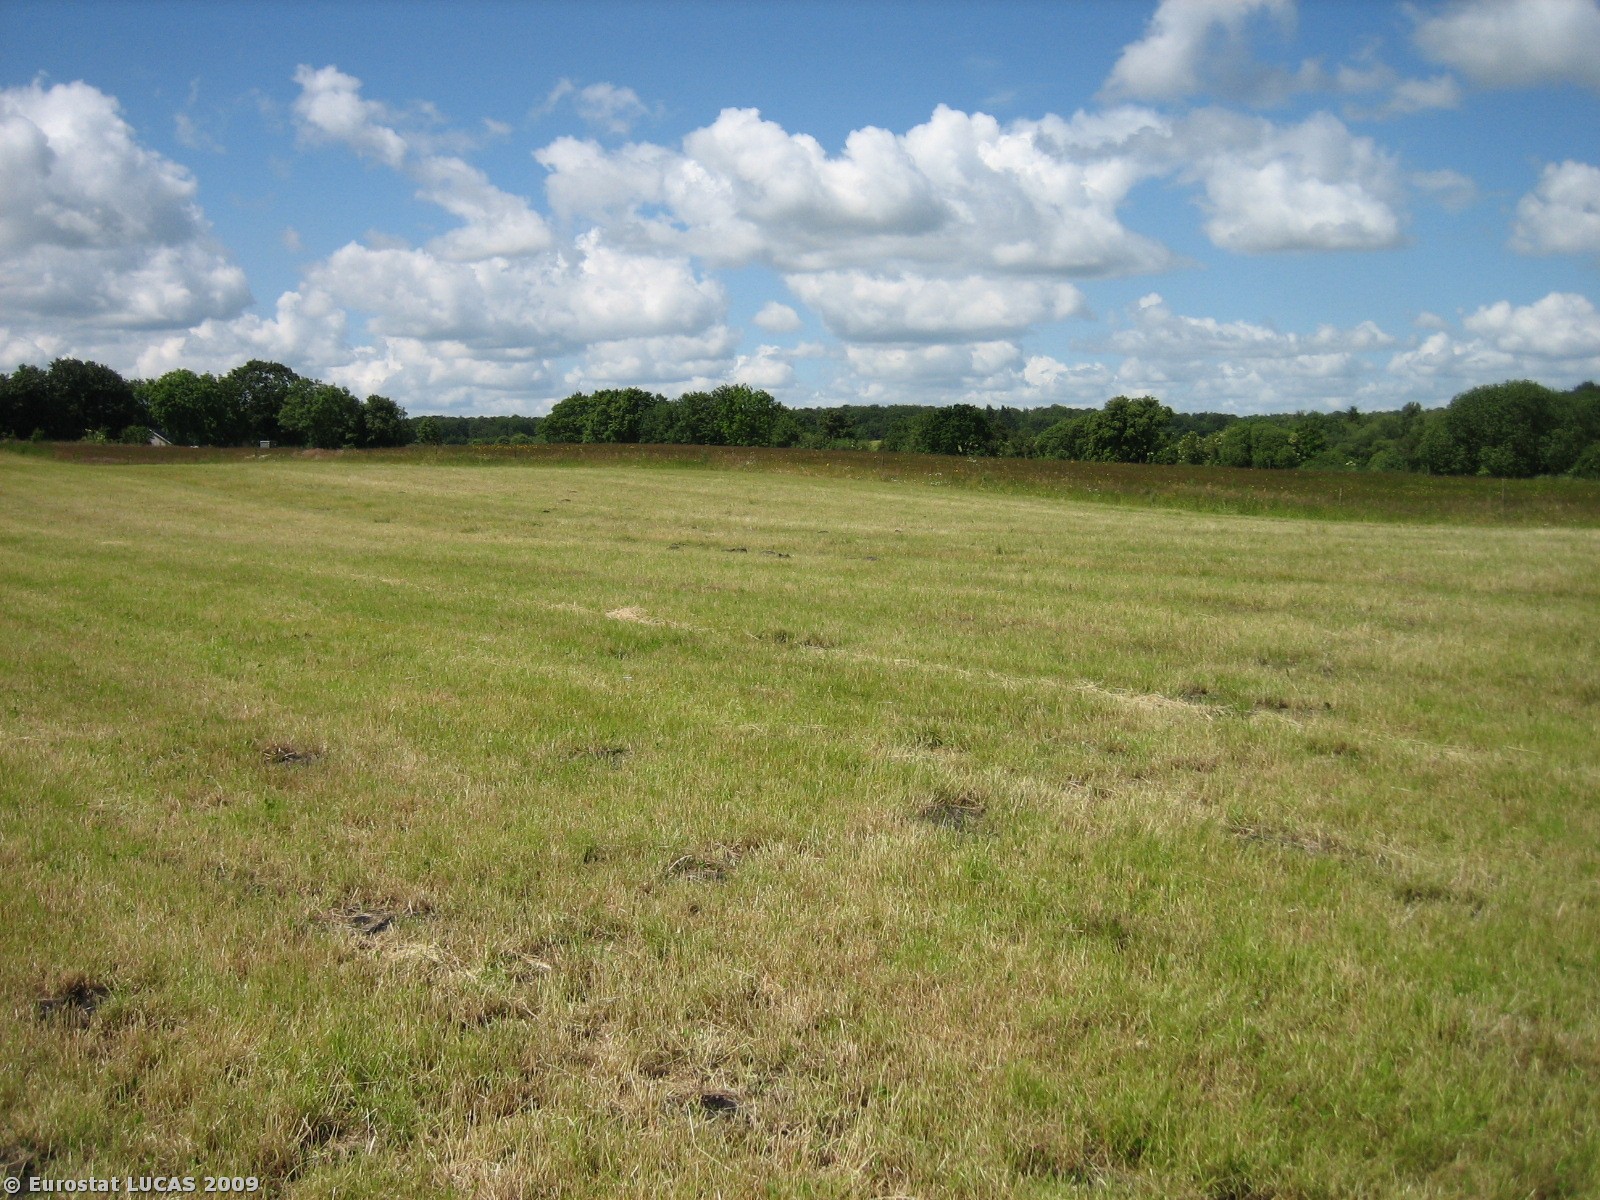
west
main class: Cropland
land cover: Temporary grasslands
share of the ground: > 75 %
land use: Agriculture (excluding fallow land and kitchen gardens)
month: June
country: DK
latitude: 55.5927
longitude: 9.3183
